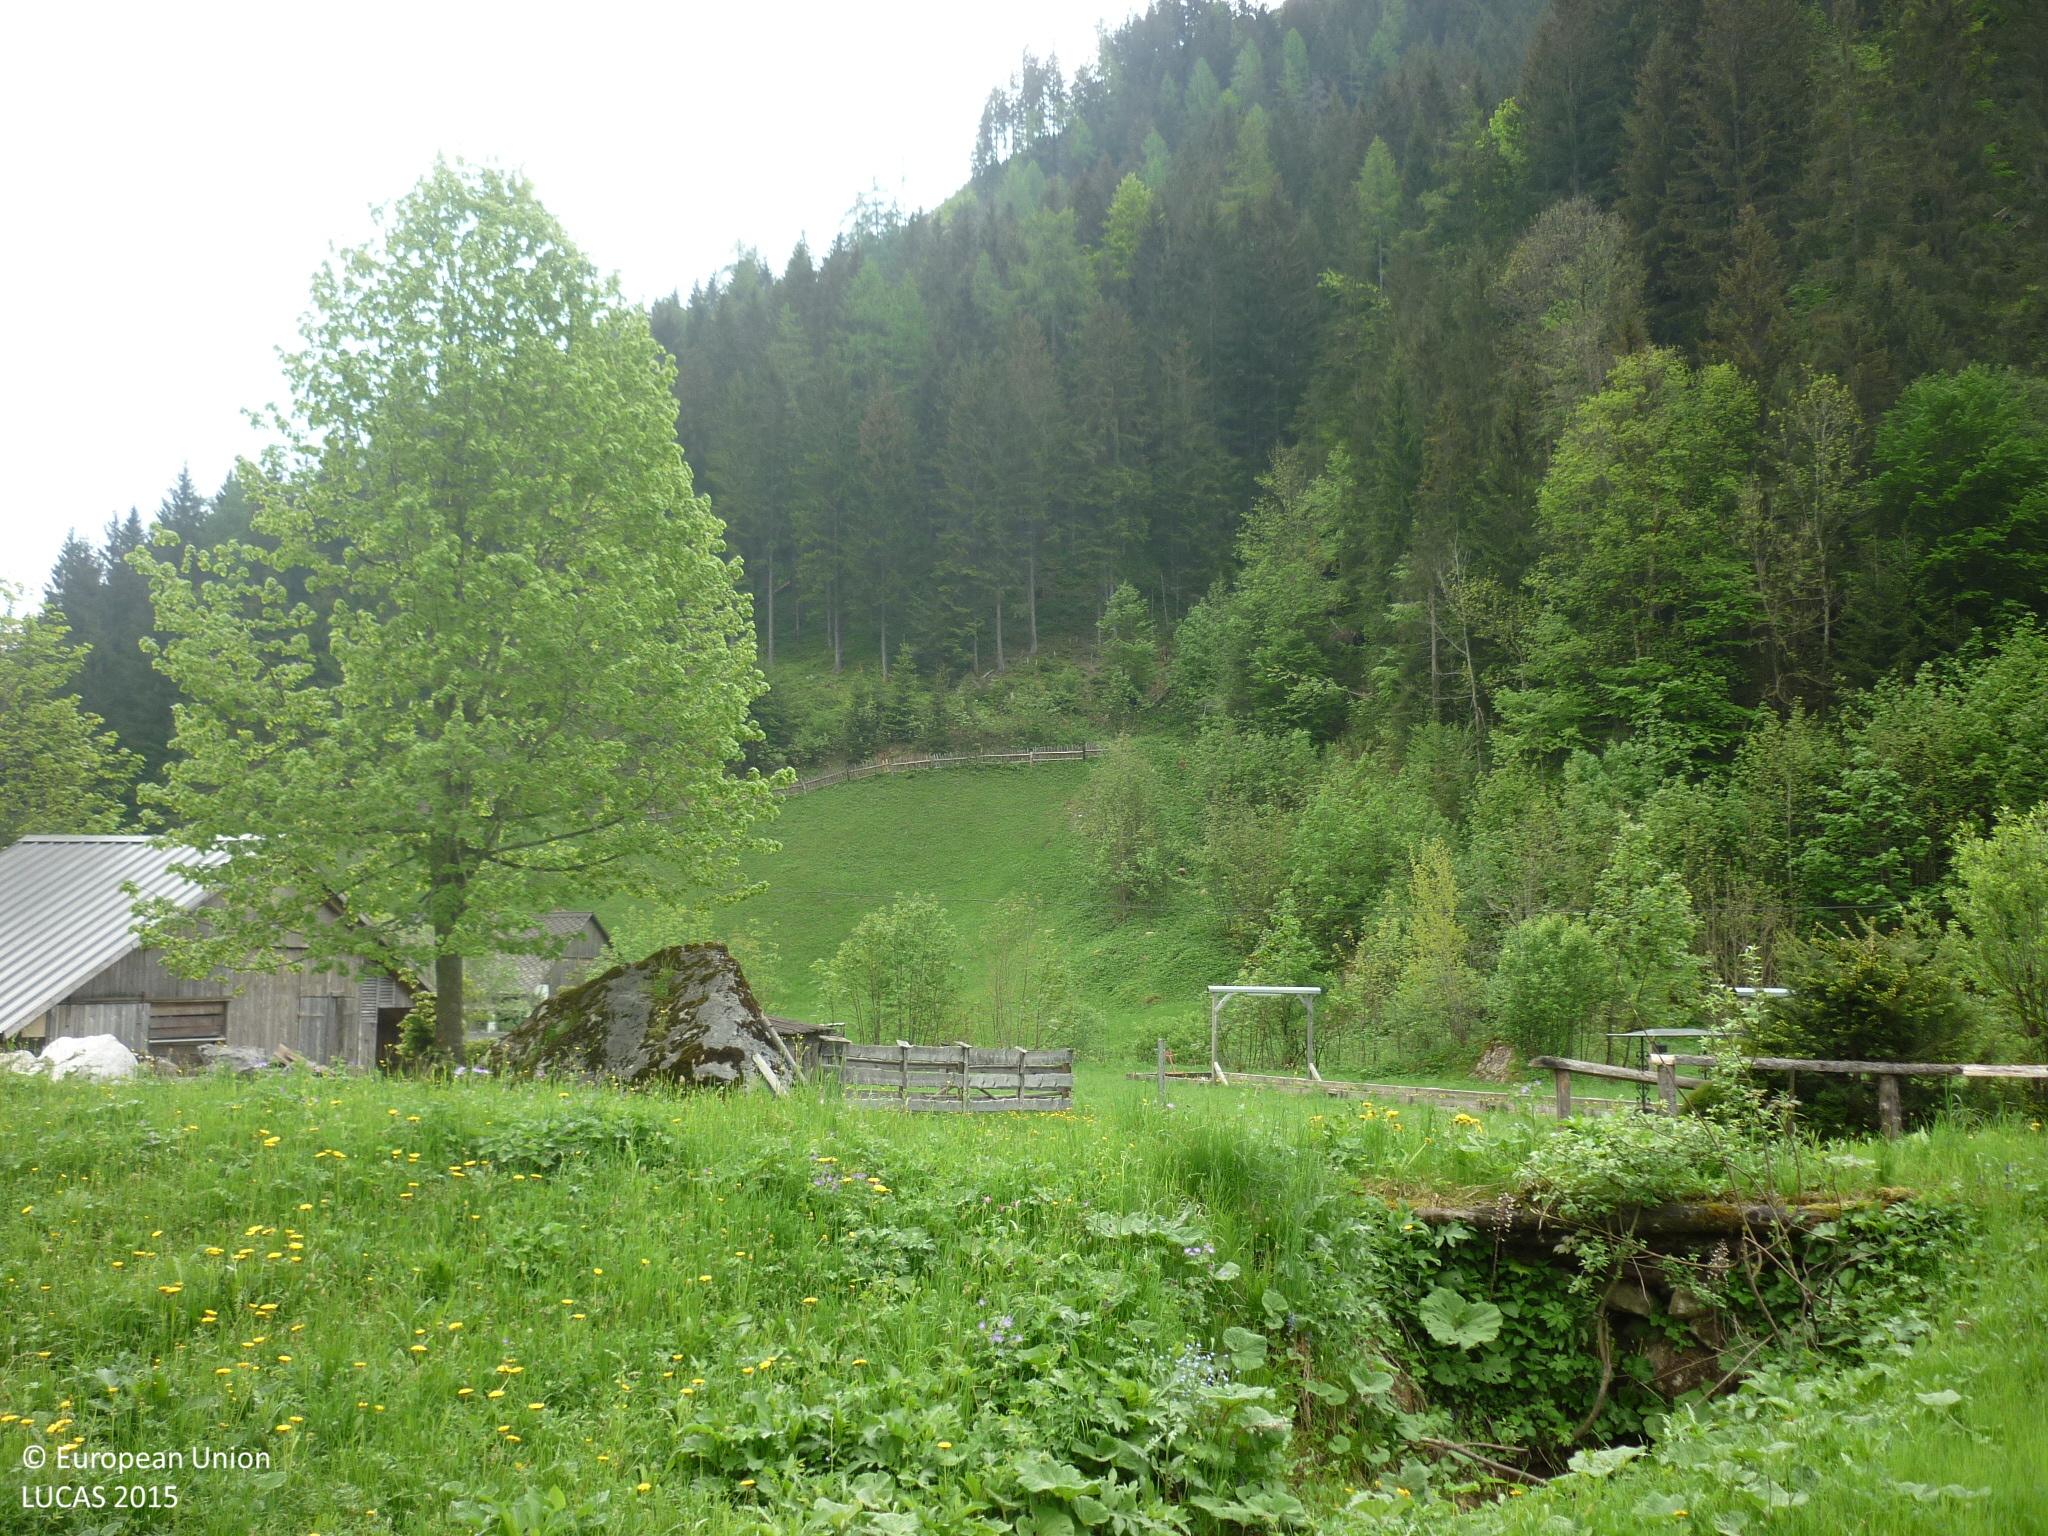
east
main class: Grassland
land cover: Grassland without tree/shrub cover
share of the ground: > 75 %
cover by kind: herbaceous plants 100 %
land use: Agriculture (excluding fallow land and kitchen gardens)
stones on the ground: < 10 %
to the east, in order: Grassland without tree/shrub cover; Artificial constructions in urban areas; Grassland without tree/shrub cover; Abandoned hedges; Rivers and streams; Shruby margins; Grassland without tree/shrub cover; Fences; Spruce dominated mixed woodland; Spruce dominated coniferous woodland; Rivers and streams; Spruce dominated coniferous woodland
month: May
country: AT
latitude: 47.5278
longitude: 14.7147
